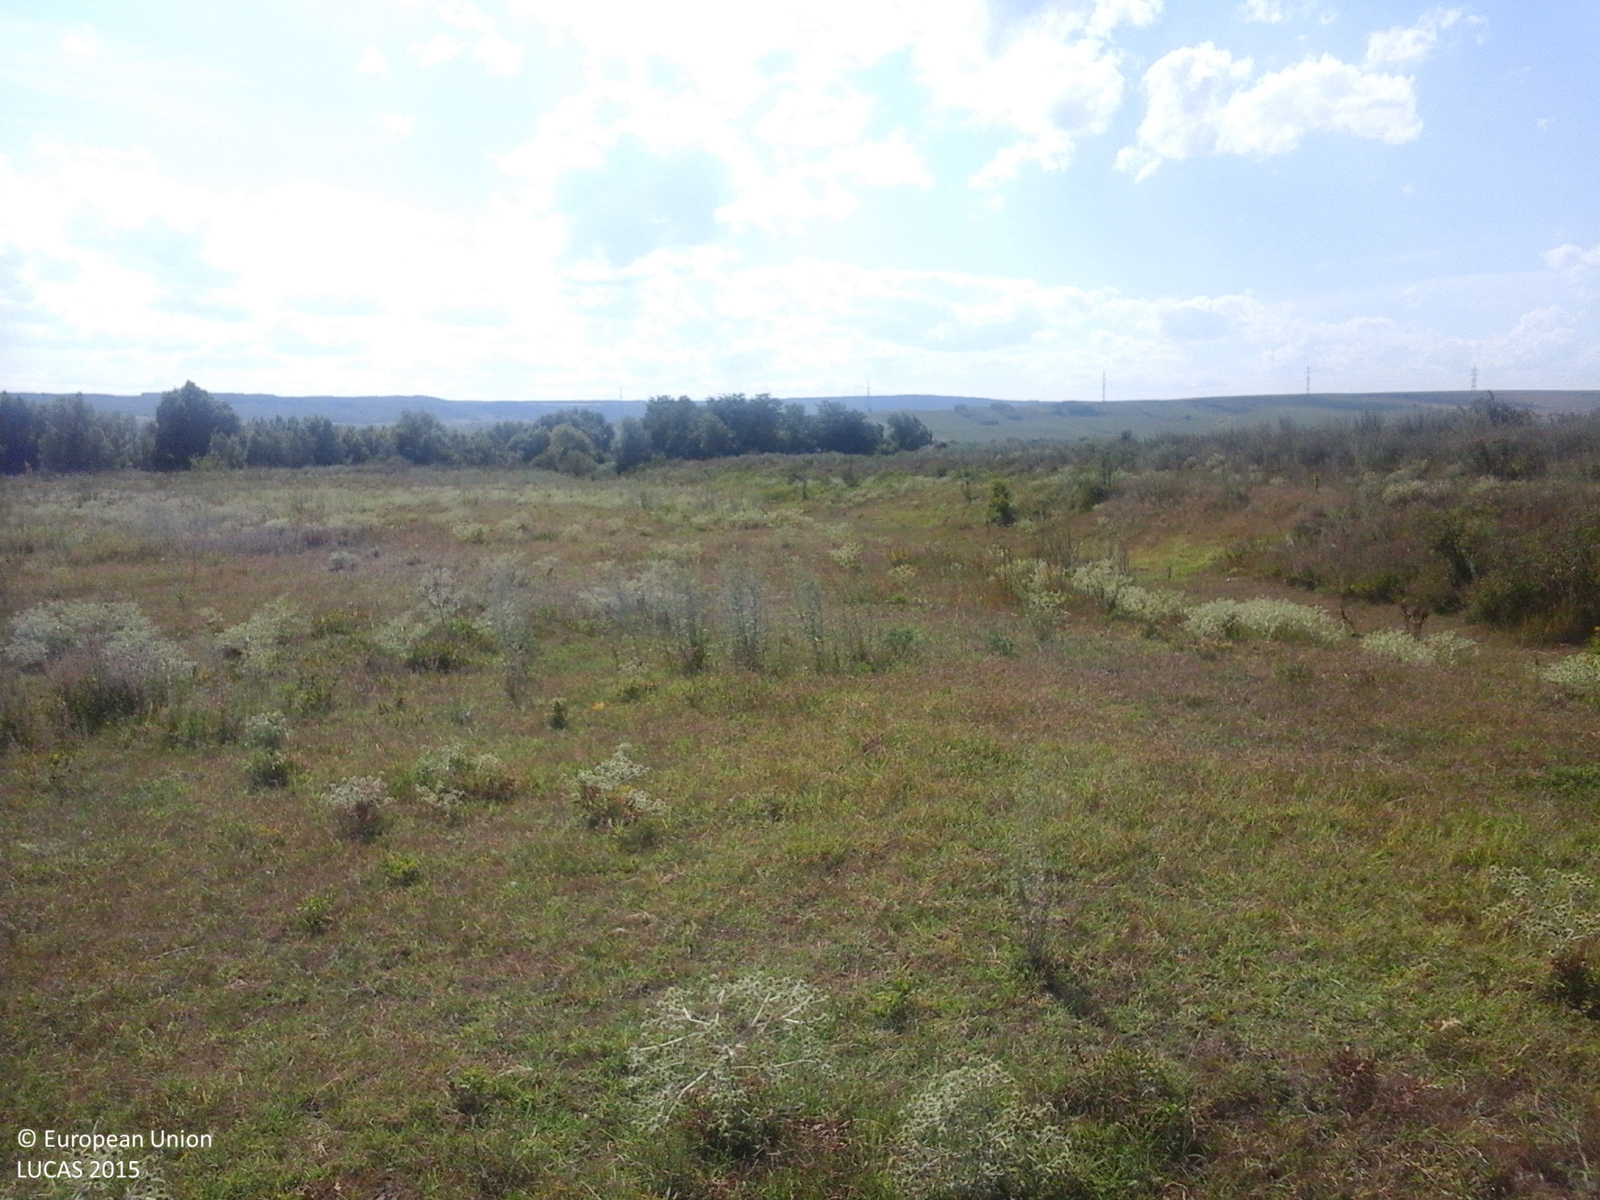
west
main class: Grassland
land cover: Grassland without tree/shrub cover
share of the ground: > 75 %
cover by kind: herbaceous plants 100 %
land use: Agriculture (excluding fallow land and kitchen gardens)
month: July
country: RO
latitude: 46.4963
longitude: 27.8278
